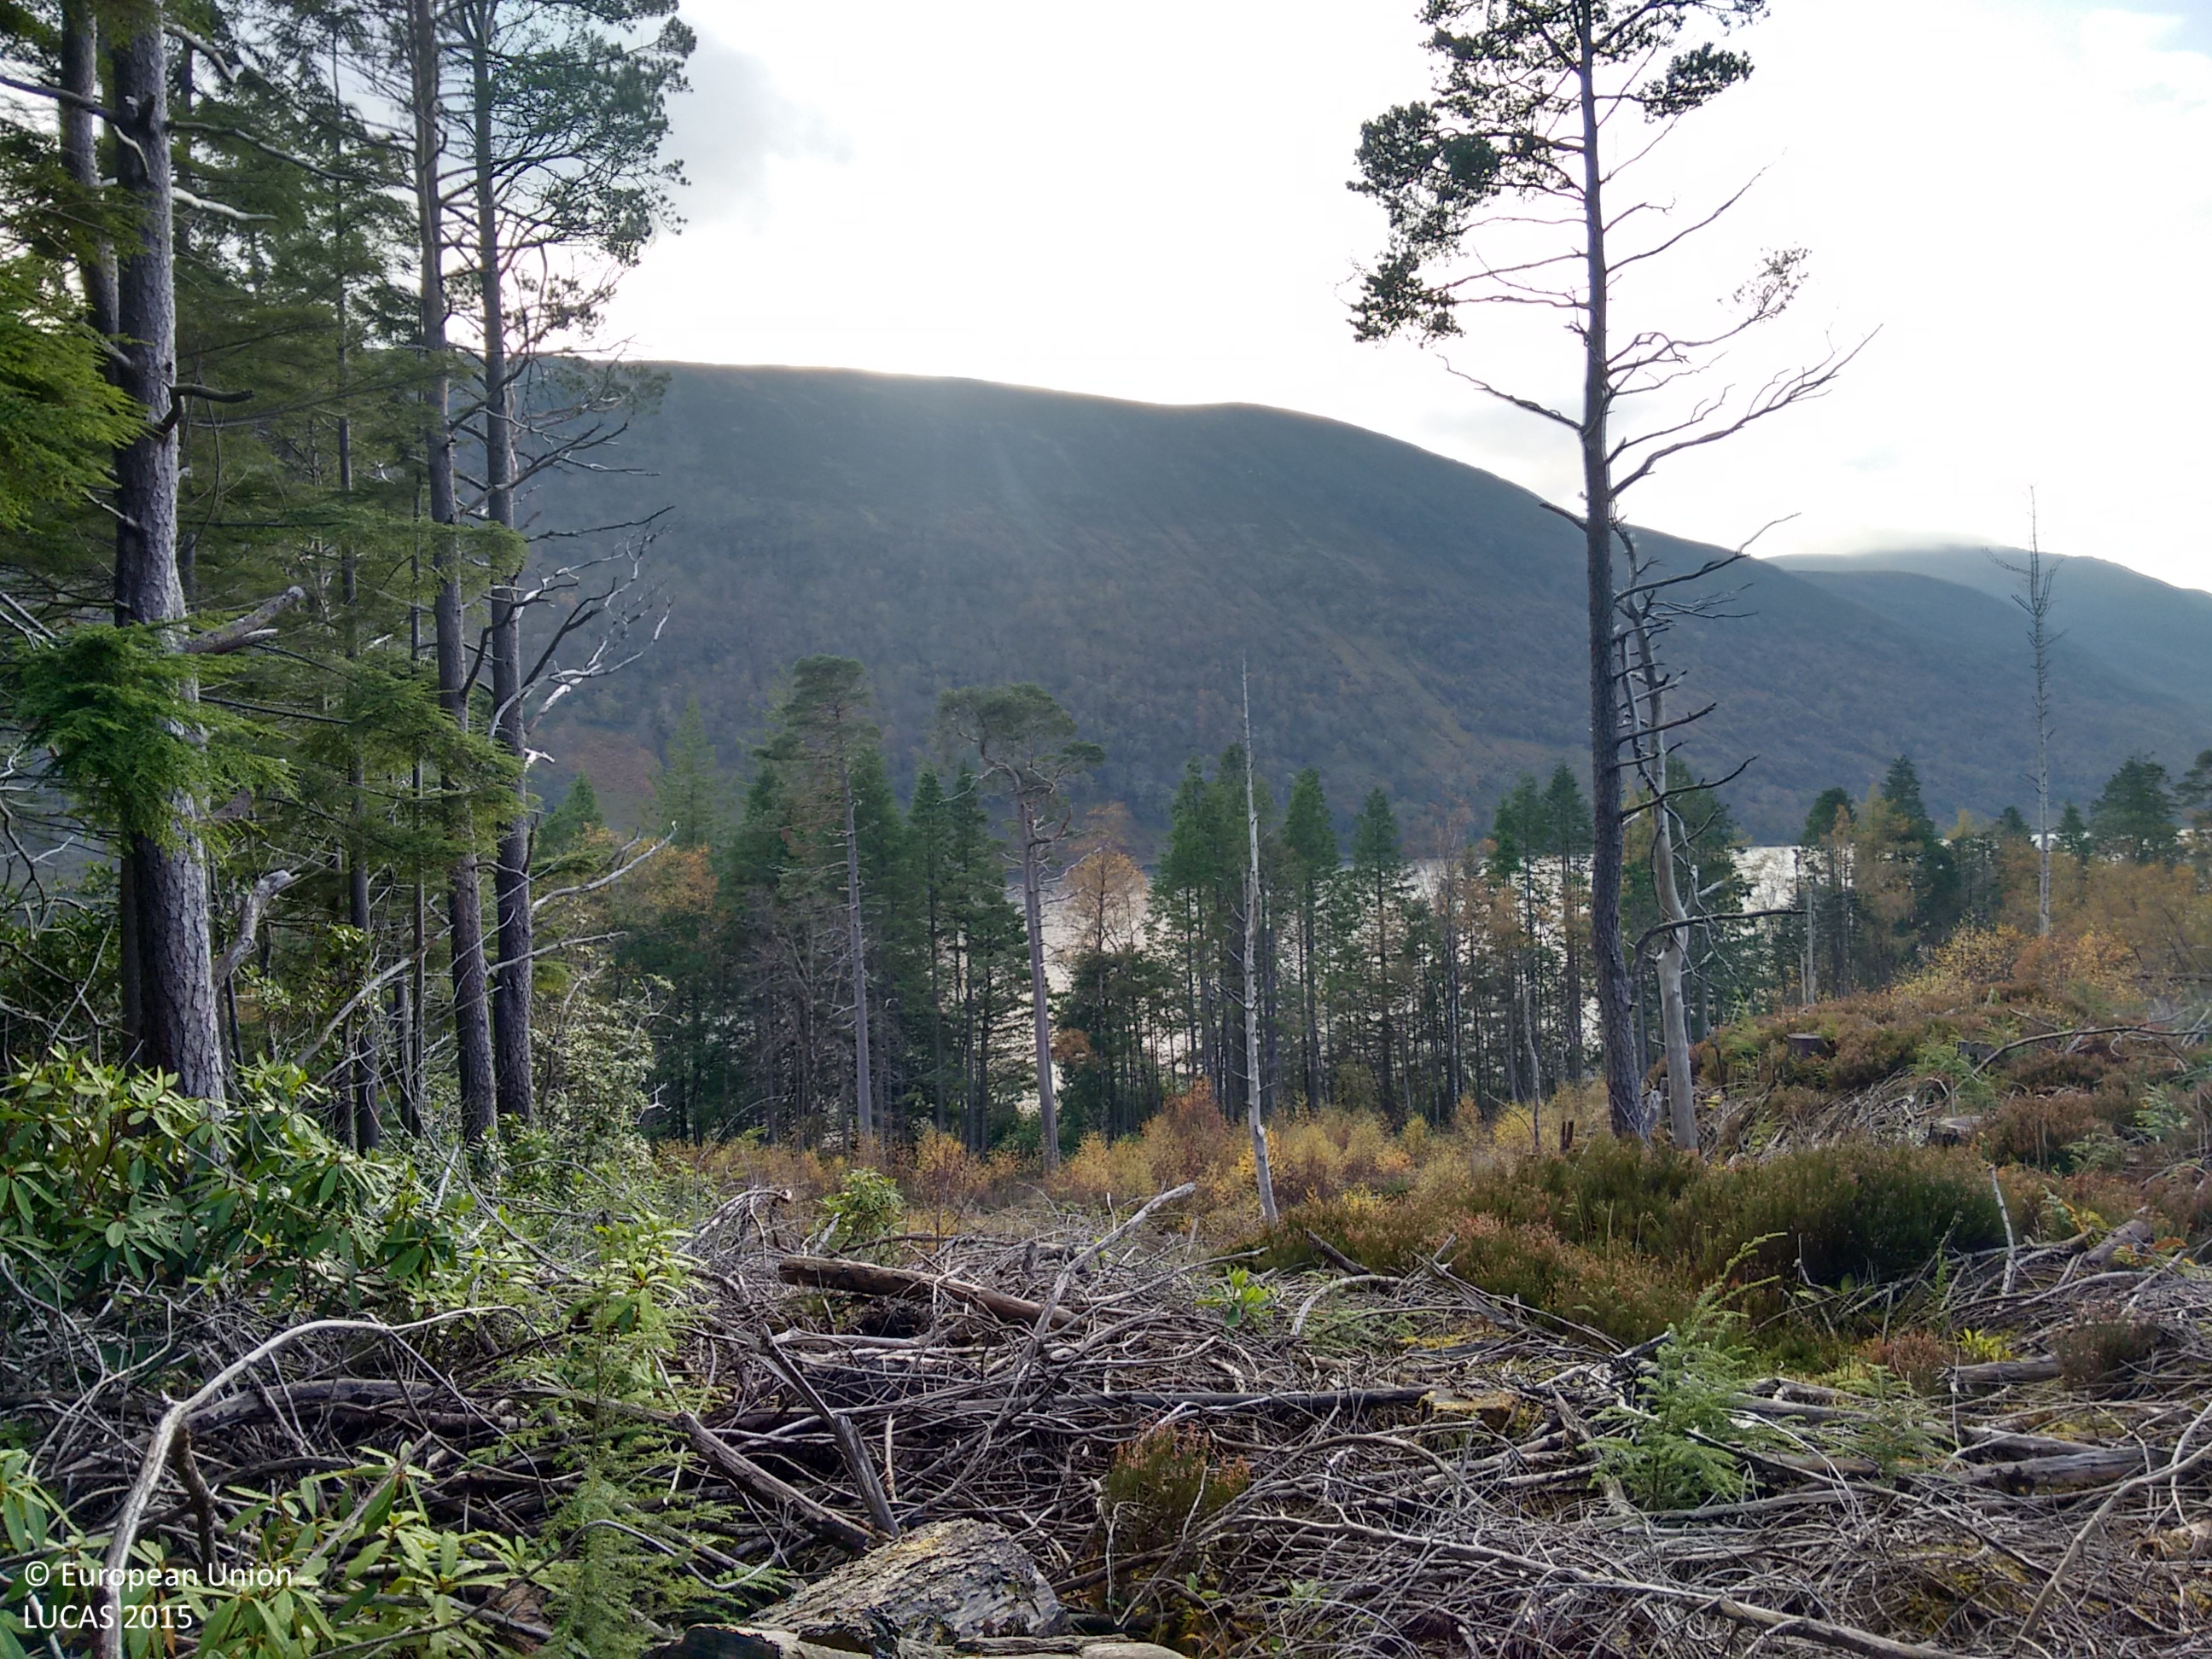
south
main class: Woodland
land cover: Spruce dominated mixed woodland
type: exotic forest
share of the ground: 50 - 75 %
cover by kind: coniferous forest trees 40 %, broadleaved forest trees 25 %, unconsolidated bare surface 25 %, shrubs 5 %, herbaceous plants 5 %
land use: Forestry
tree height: > 5 m
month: November
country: GB
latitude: 57.4781
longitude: -5.3373
